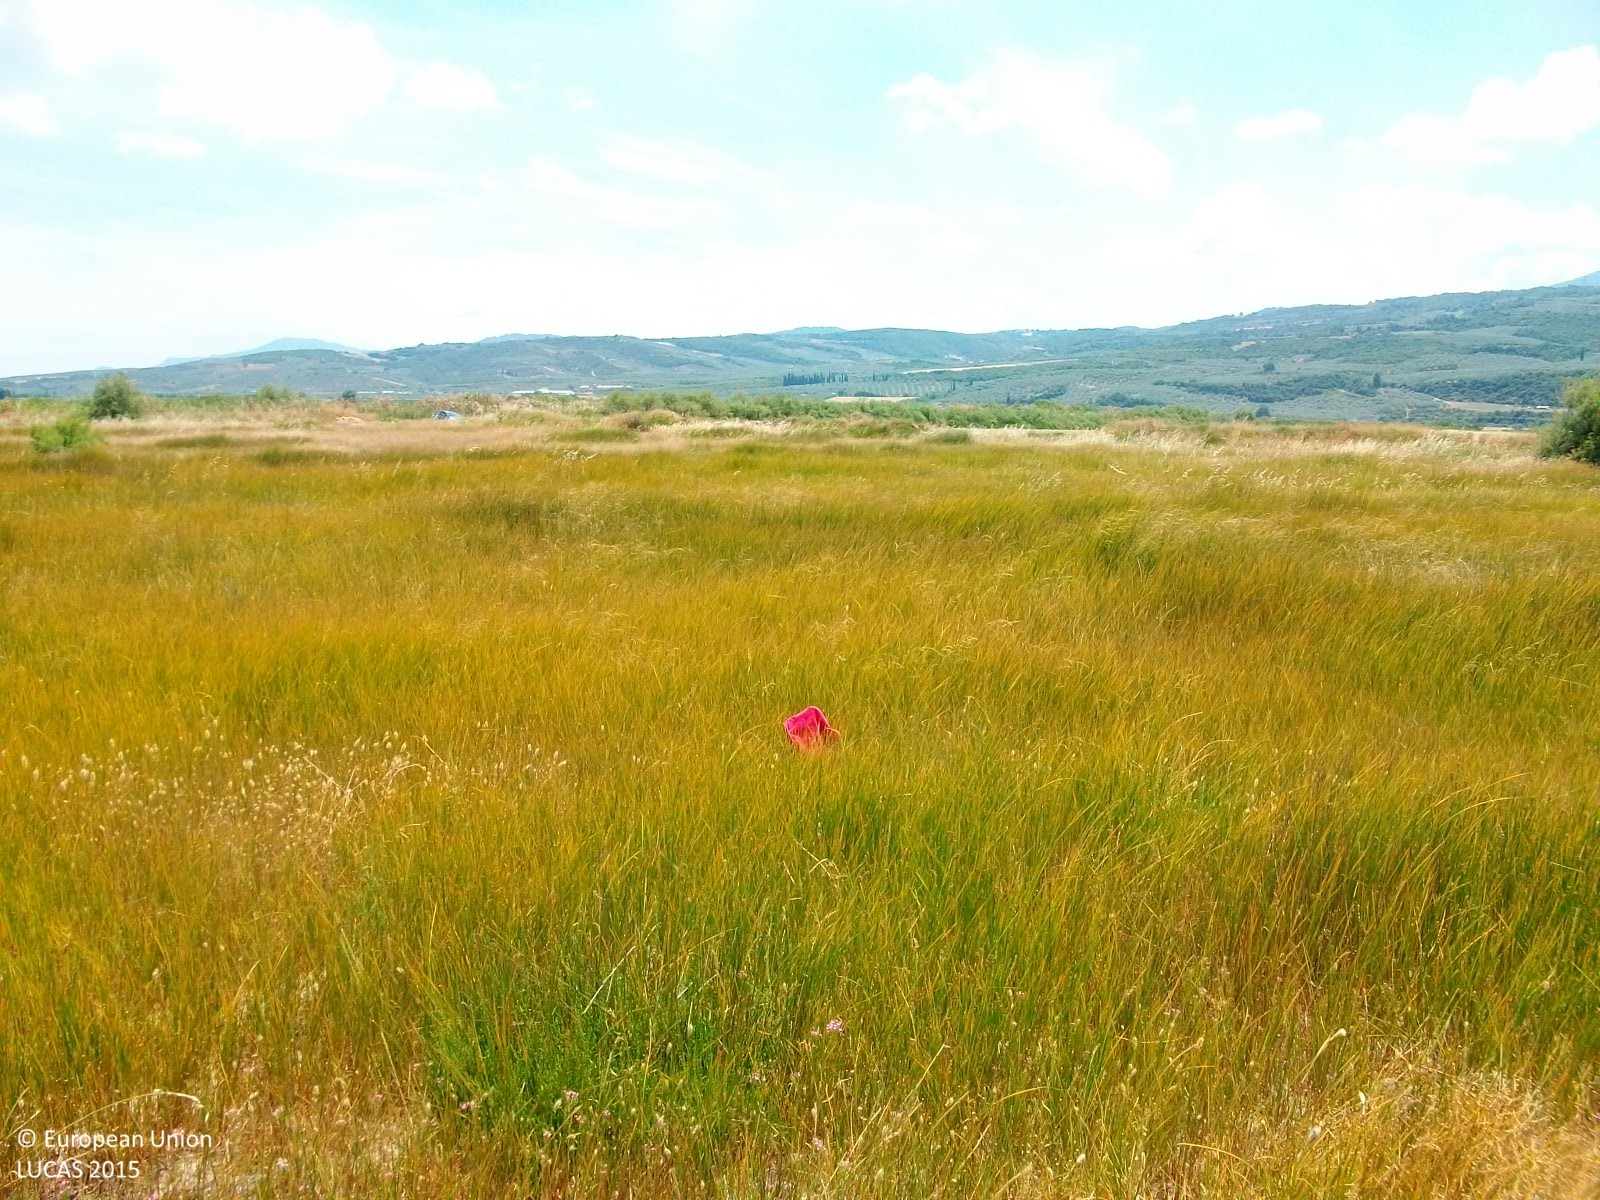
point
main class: Grassland
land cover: Spontaneously vegetated surfaces
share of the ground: > 75 %
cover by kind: herbaceous plants 100 %
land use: Fallow land
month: June
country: GR
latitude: 38.8152
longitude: 22.5686
